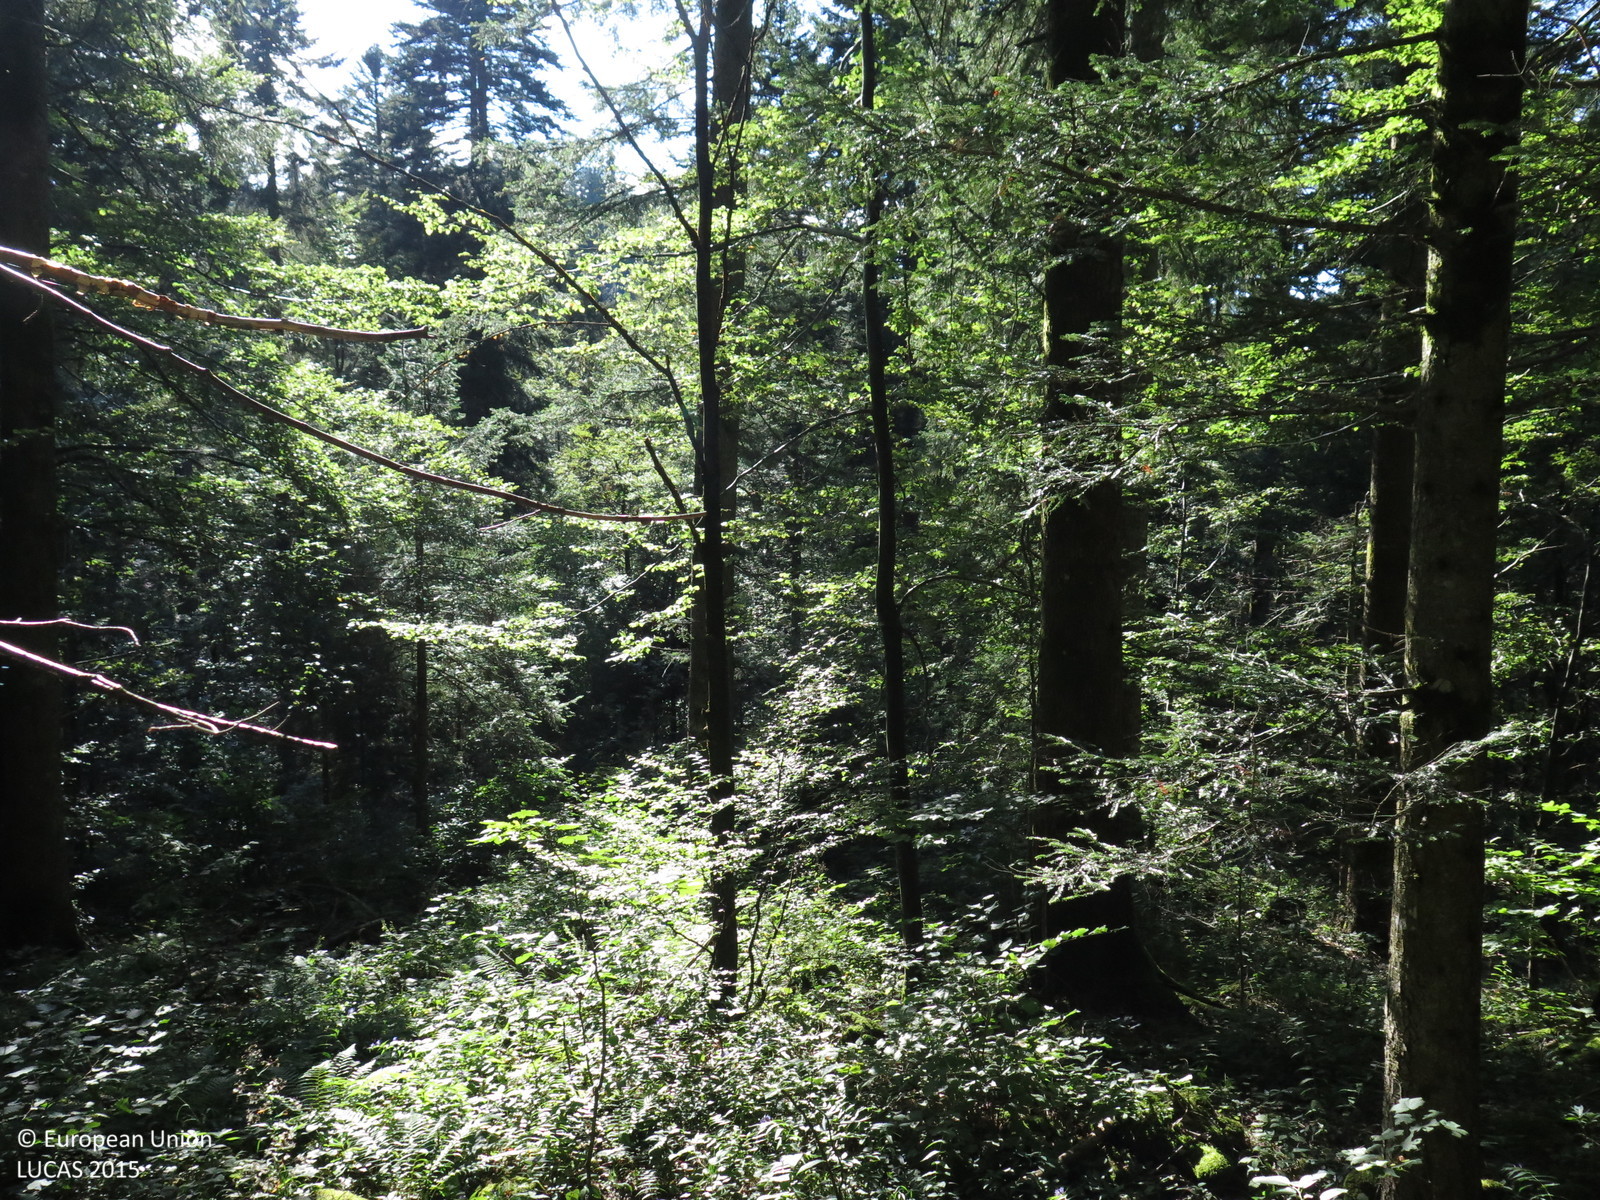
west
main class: Woodland
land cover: Other mixed woodland
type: alpine coniferous forest
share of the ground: > 75 %
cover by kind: coniferous forest trees 75 %, broadleaved forest trees 25 %
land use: Forestry
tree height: > 5 m
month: September
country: HR
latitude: 45.4522
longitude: 14.7393
